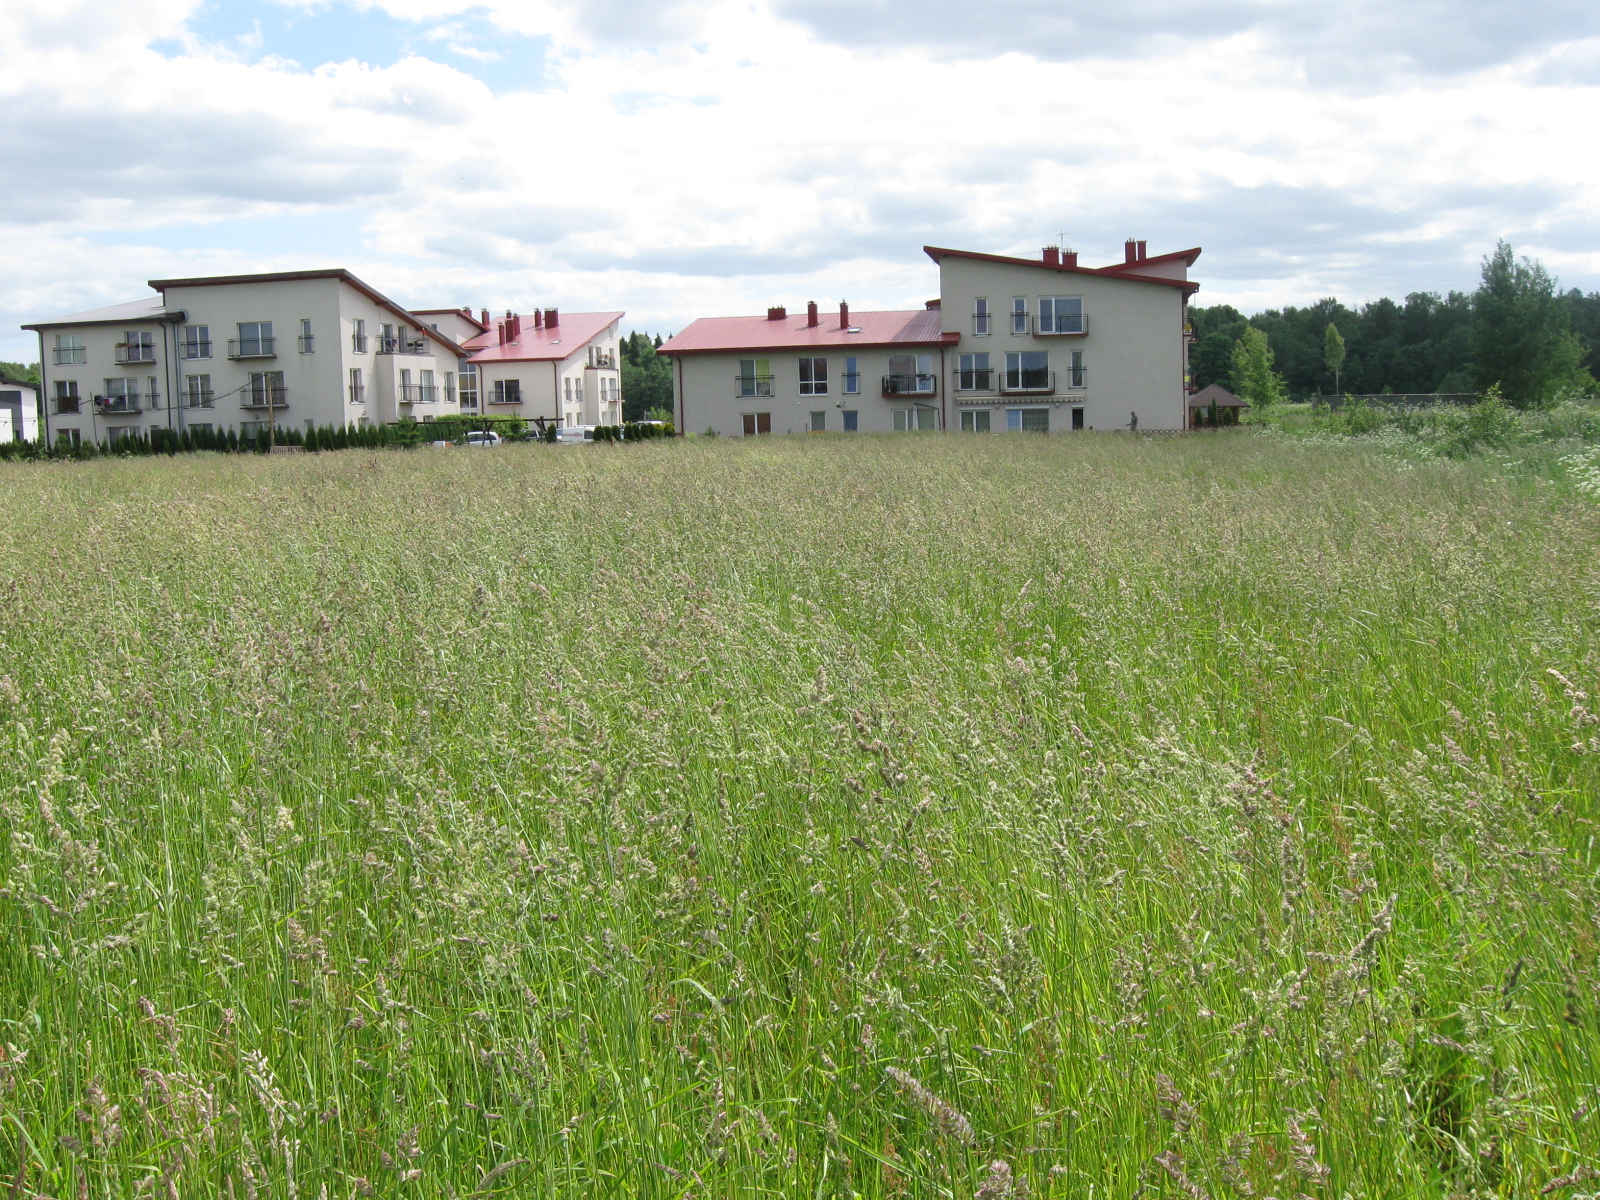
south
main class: Grassland
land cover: Grassland without tree/shrub cover
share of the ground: > 75 %
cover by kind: herbaceous plants 100 %
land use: Agriculture (excluding fallow land and kitchen gardens)
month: June
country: LT
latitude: 54.9606
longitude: 23.8150
